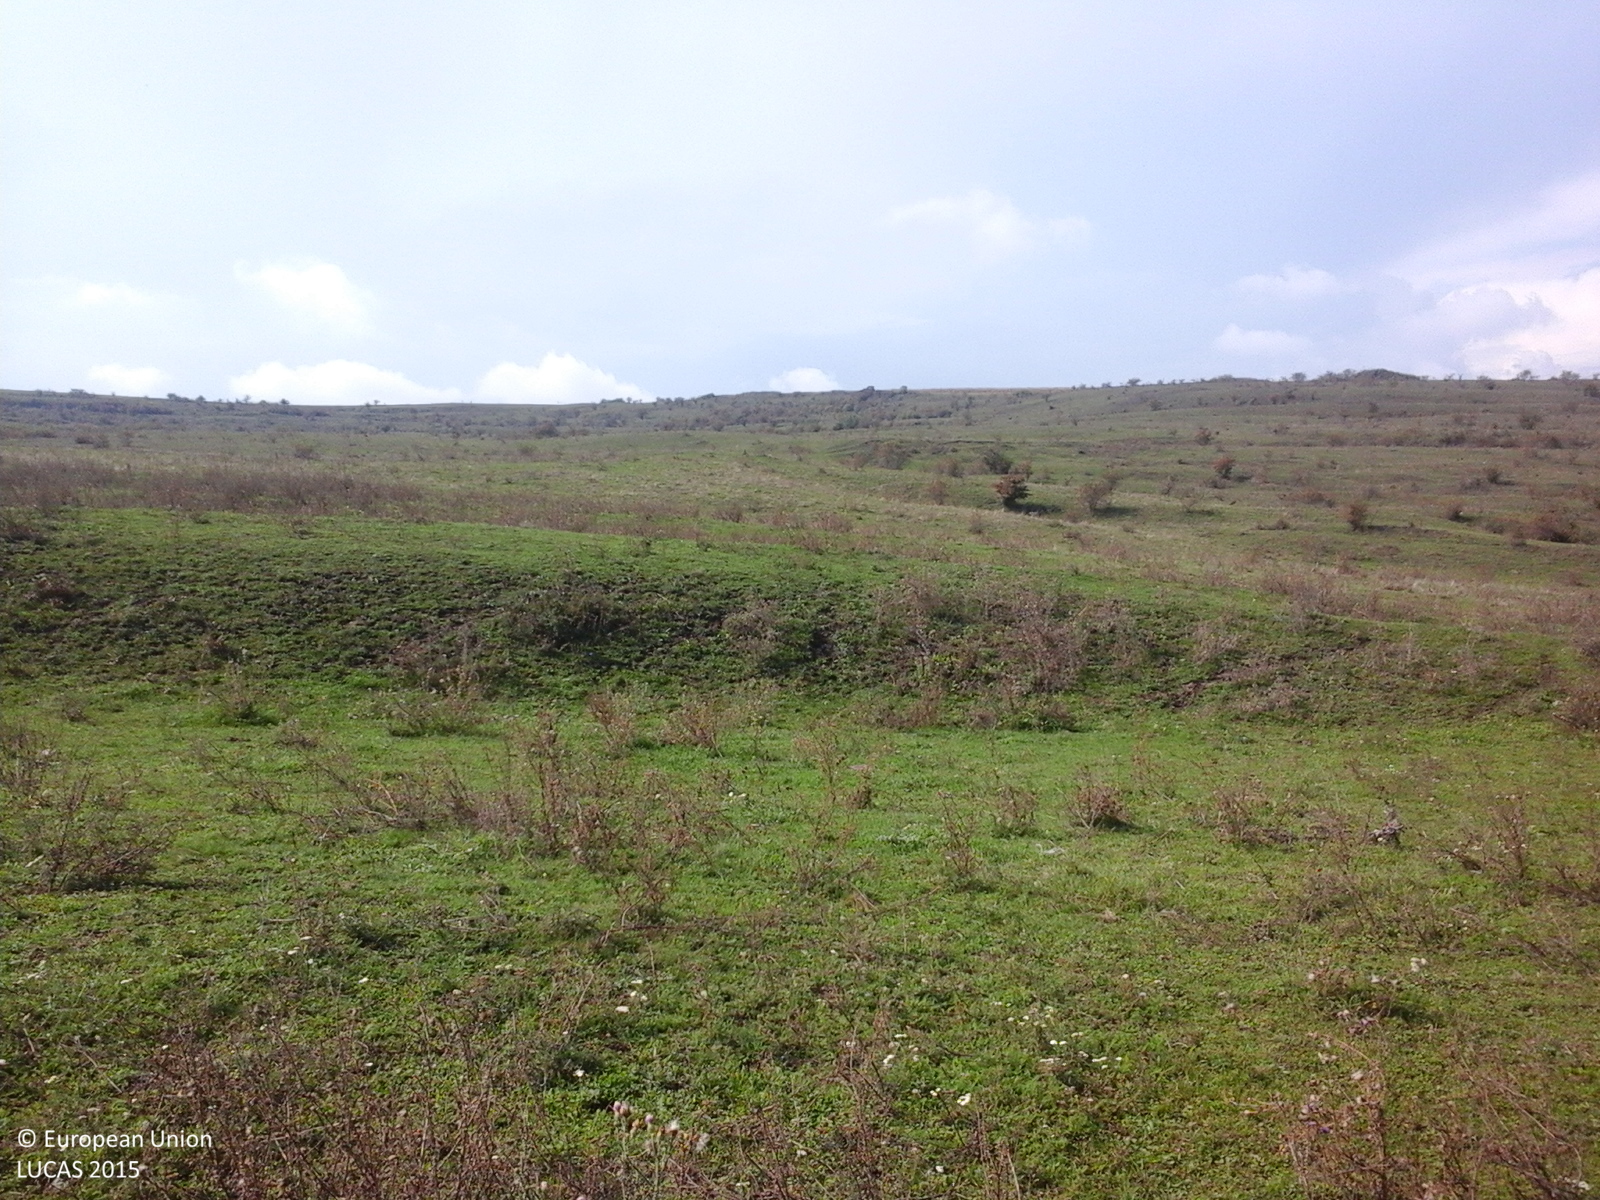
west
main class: Grassland
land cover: Spontaneously vegetated surfaces
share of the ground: > 75 %
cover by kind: herbaceous plants 100 %
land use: Agriculture (excluding fallow land and kitchen gardens)
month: October
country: RO
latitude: 46.4657
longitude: 23.8645
